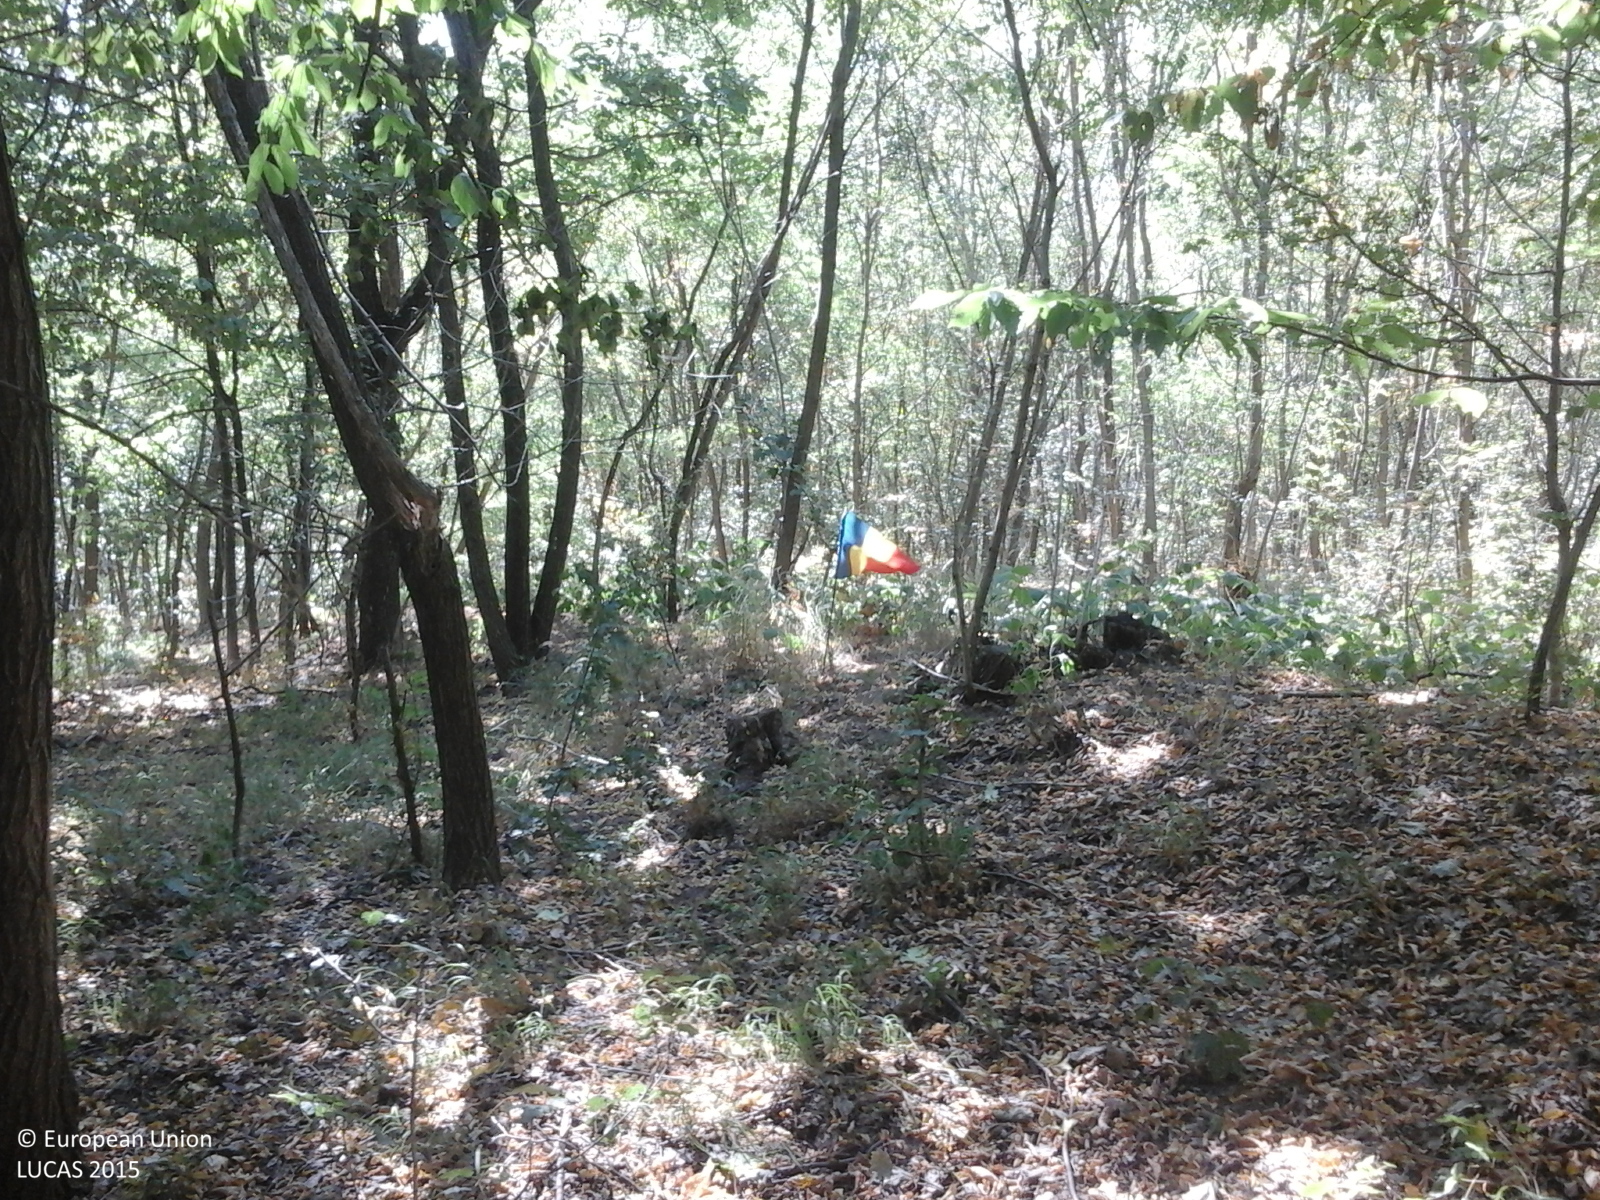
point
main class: Woodland
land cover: Broadleaved woodland
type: exotic forest
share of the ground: > 75 %
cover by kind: broadleaved forest trees 100 %
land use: Forestry
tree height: > 5 m
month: July
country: RO
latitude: 46.3026
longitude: 27.3331
